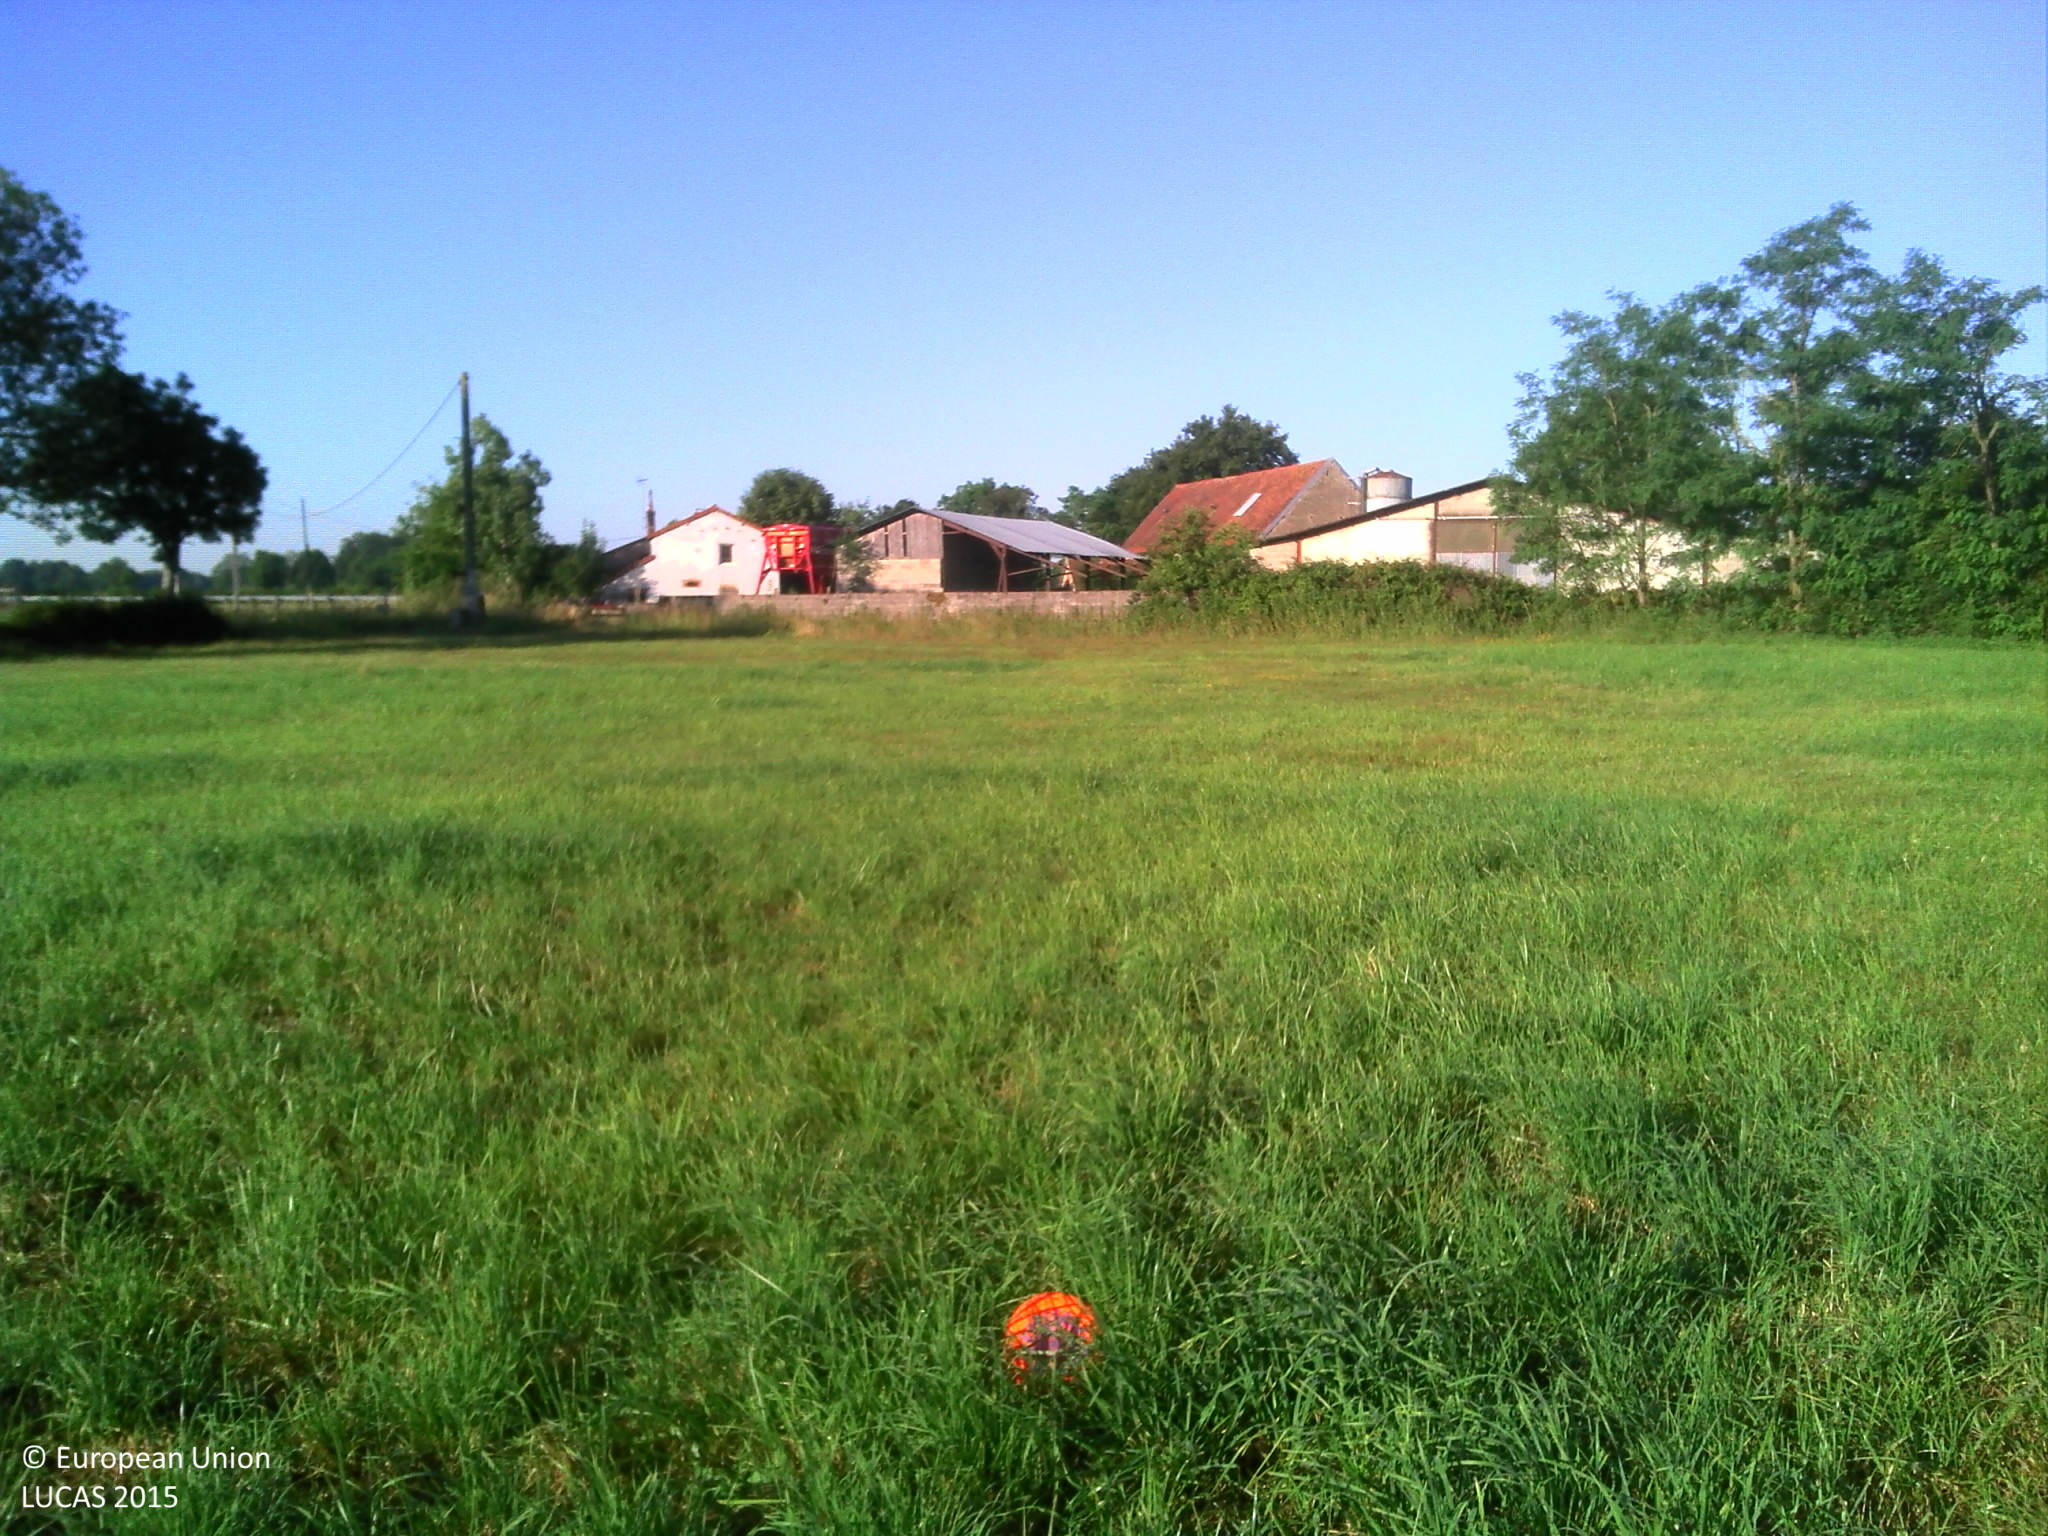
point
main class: Grassland
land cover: Grassland without tree/shrub cover
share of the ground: > 75 %
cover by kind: herbaceous plants 100 %
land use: Agriculture (excluding fallow land and kitchen gardens)
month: June
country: FR
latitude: 46.4579
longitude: 4.0763
